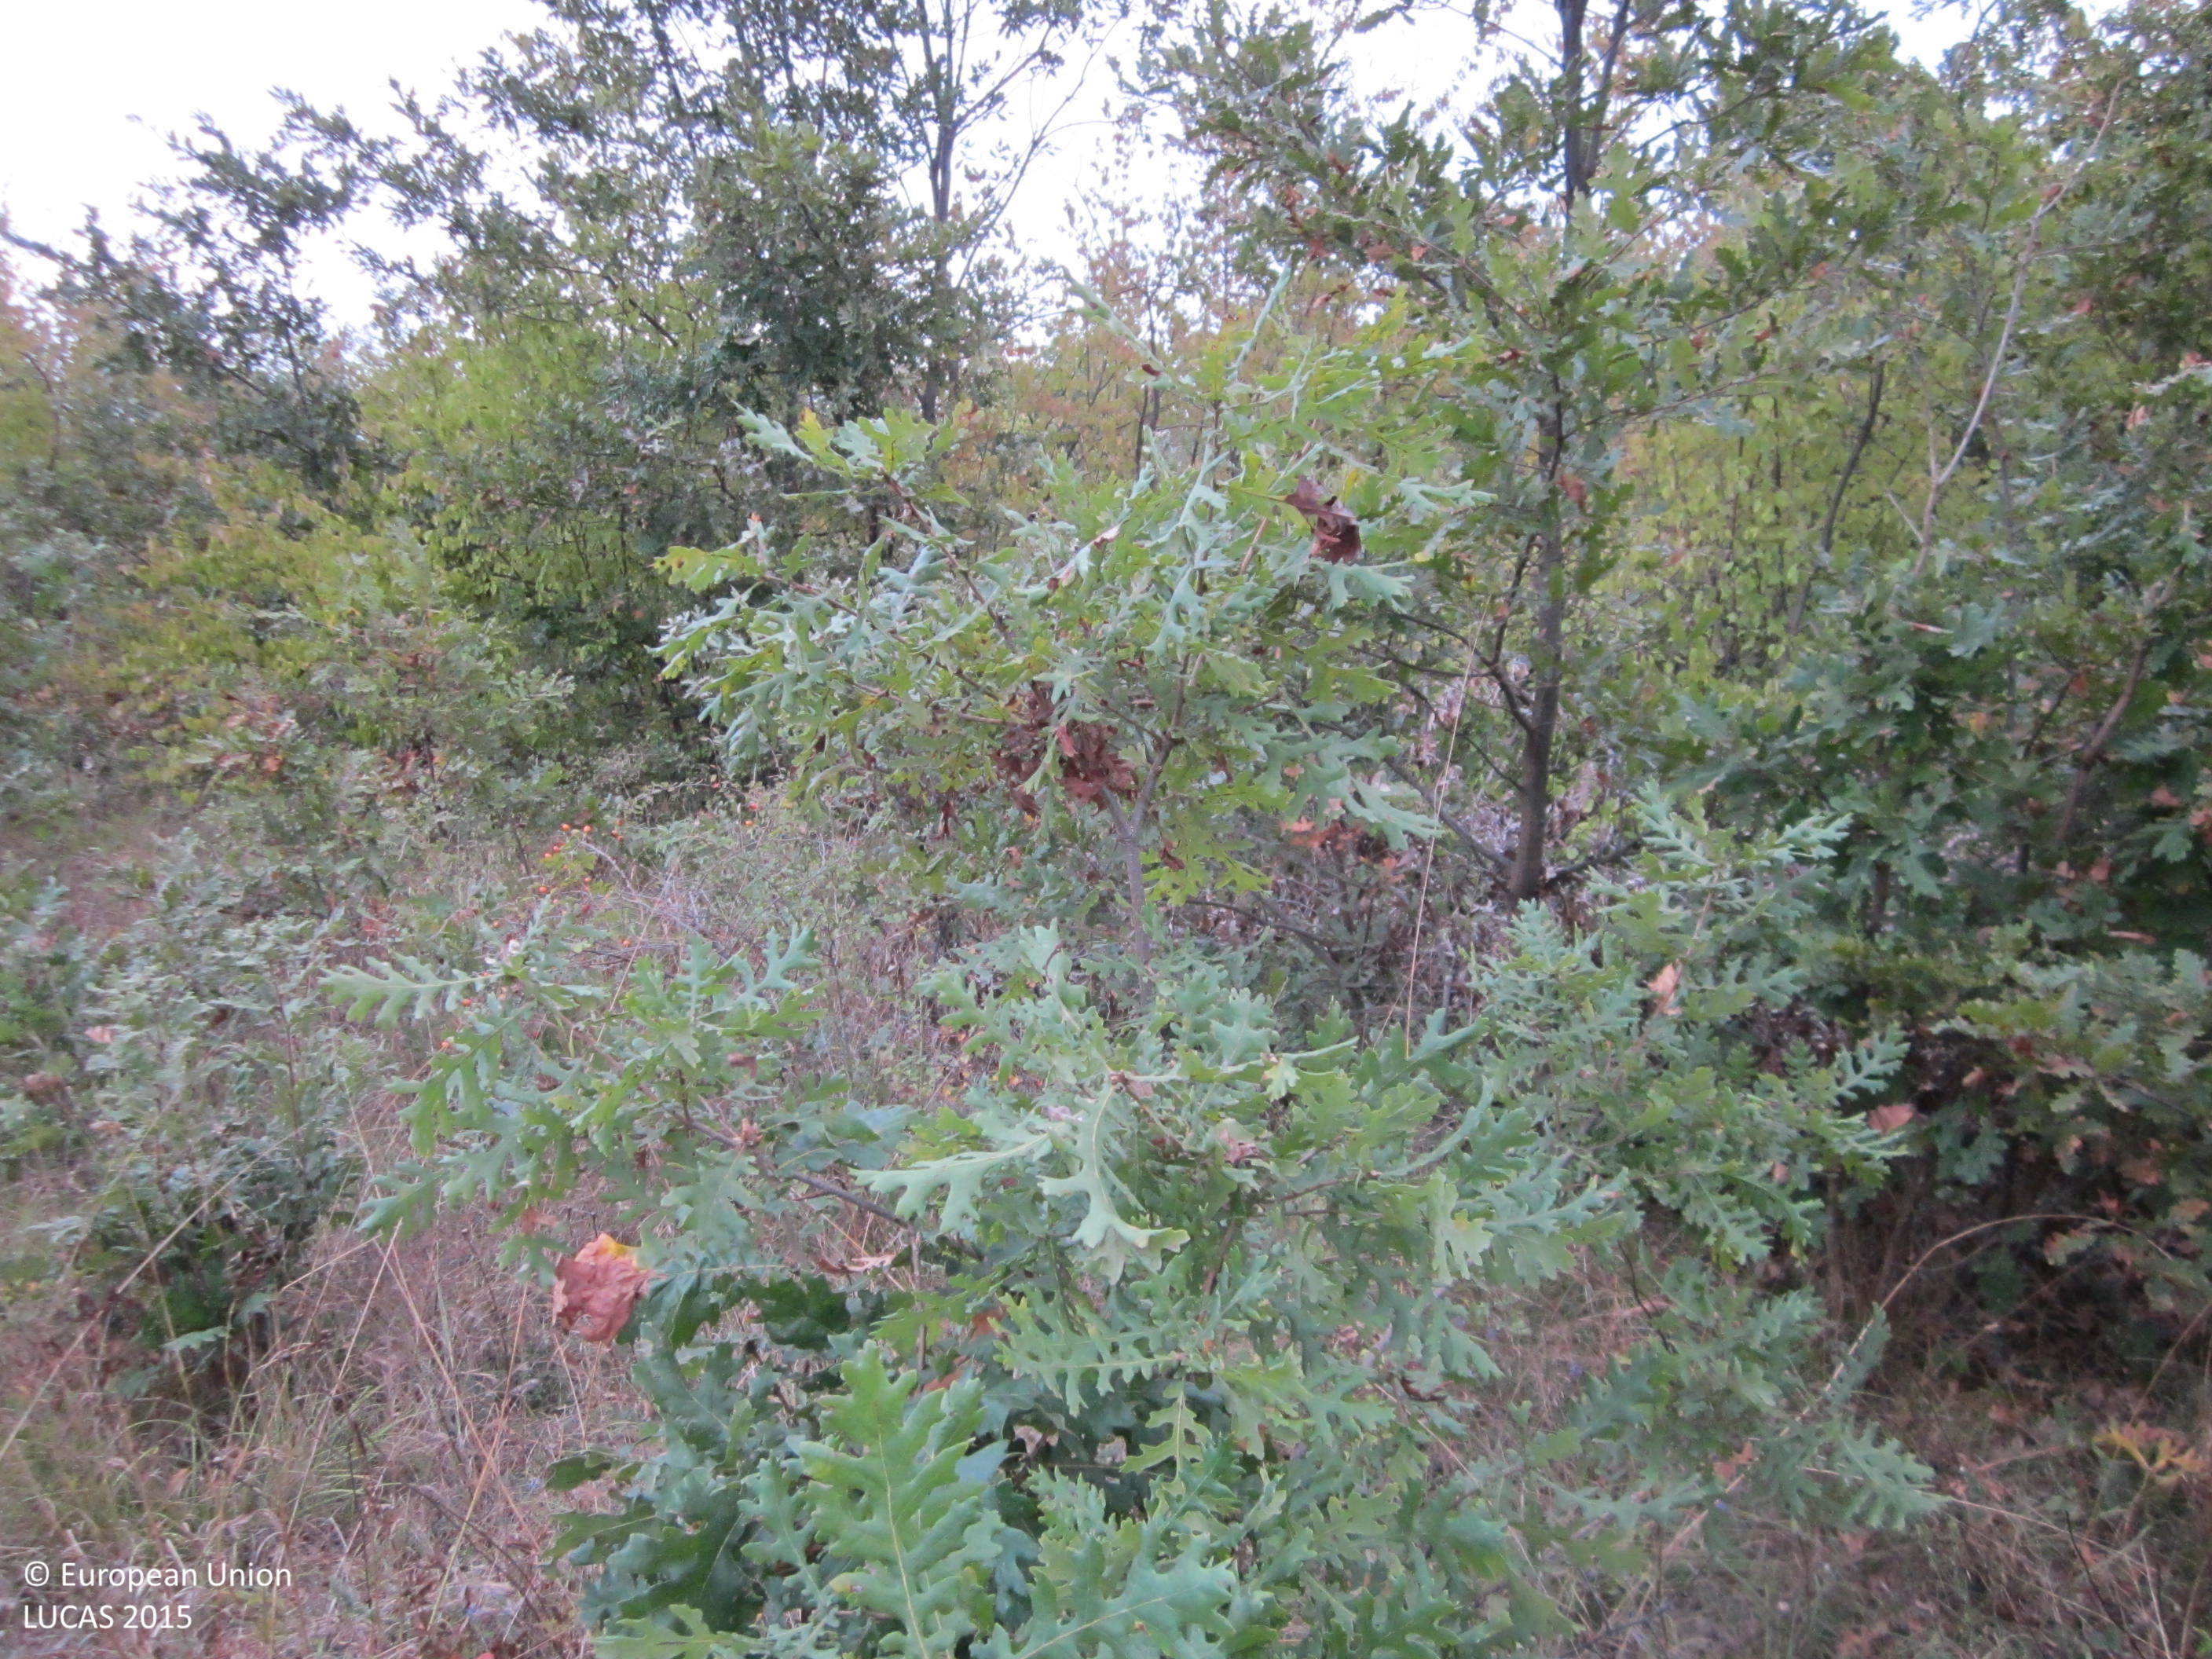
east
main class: Woodland
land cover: Broadleaved woodland
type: thermophilous deciduous forest
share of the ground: 50 - 75 %
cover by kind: broadleaved forest trees 60 %, herbaceous plants 30 %, shrubs 10 %
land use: Forestry
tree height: > 5 m
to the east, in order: Broadleaved woodland; Tracks; Broadleaved woodland
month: September
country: BG
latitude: 42.7805
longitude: 27.3651
